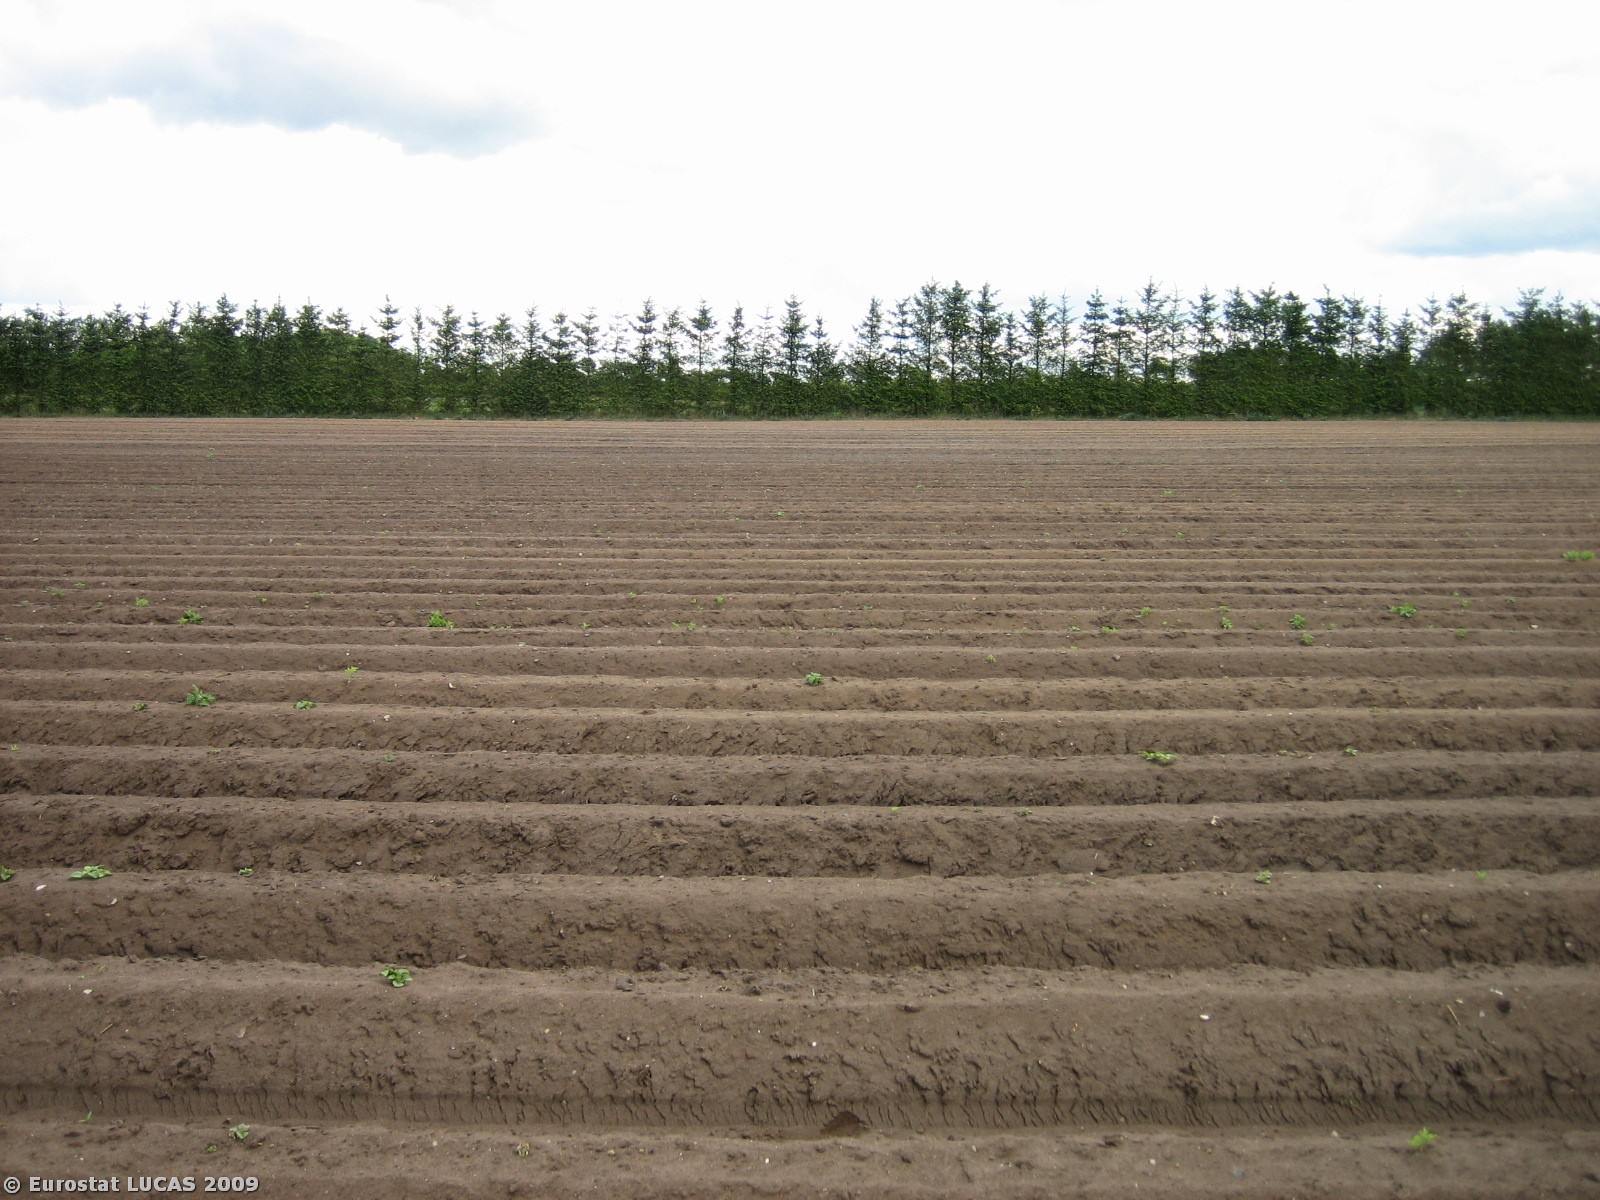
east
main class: Cropland
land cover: Potatoes
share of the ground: < 10 %
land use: Agriculture (excluding fallow land and kitchen gardens)
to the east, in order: Potatoes; Conifer hedges; Potatoes
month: June
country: DK
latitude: 56.0241
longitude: 9.3109
